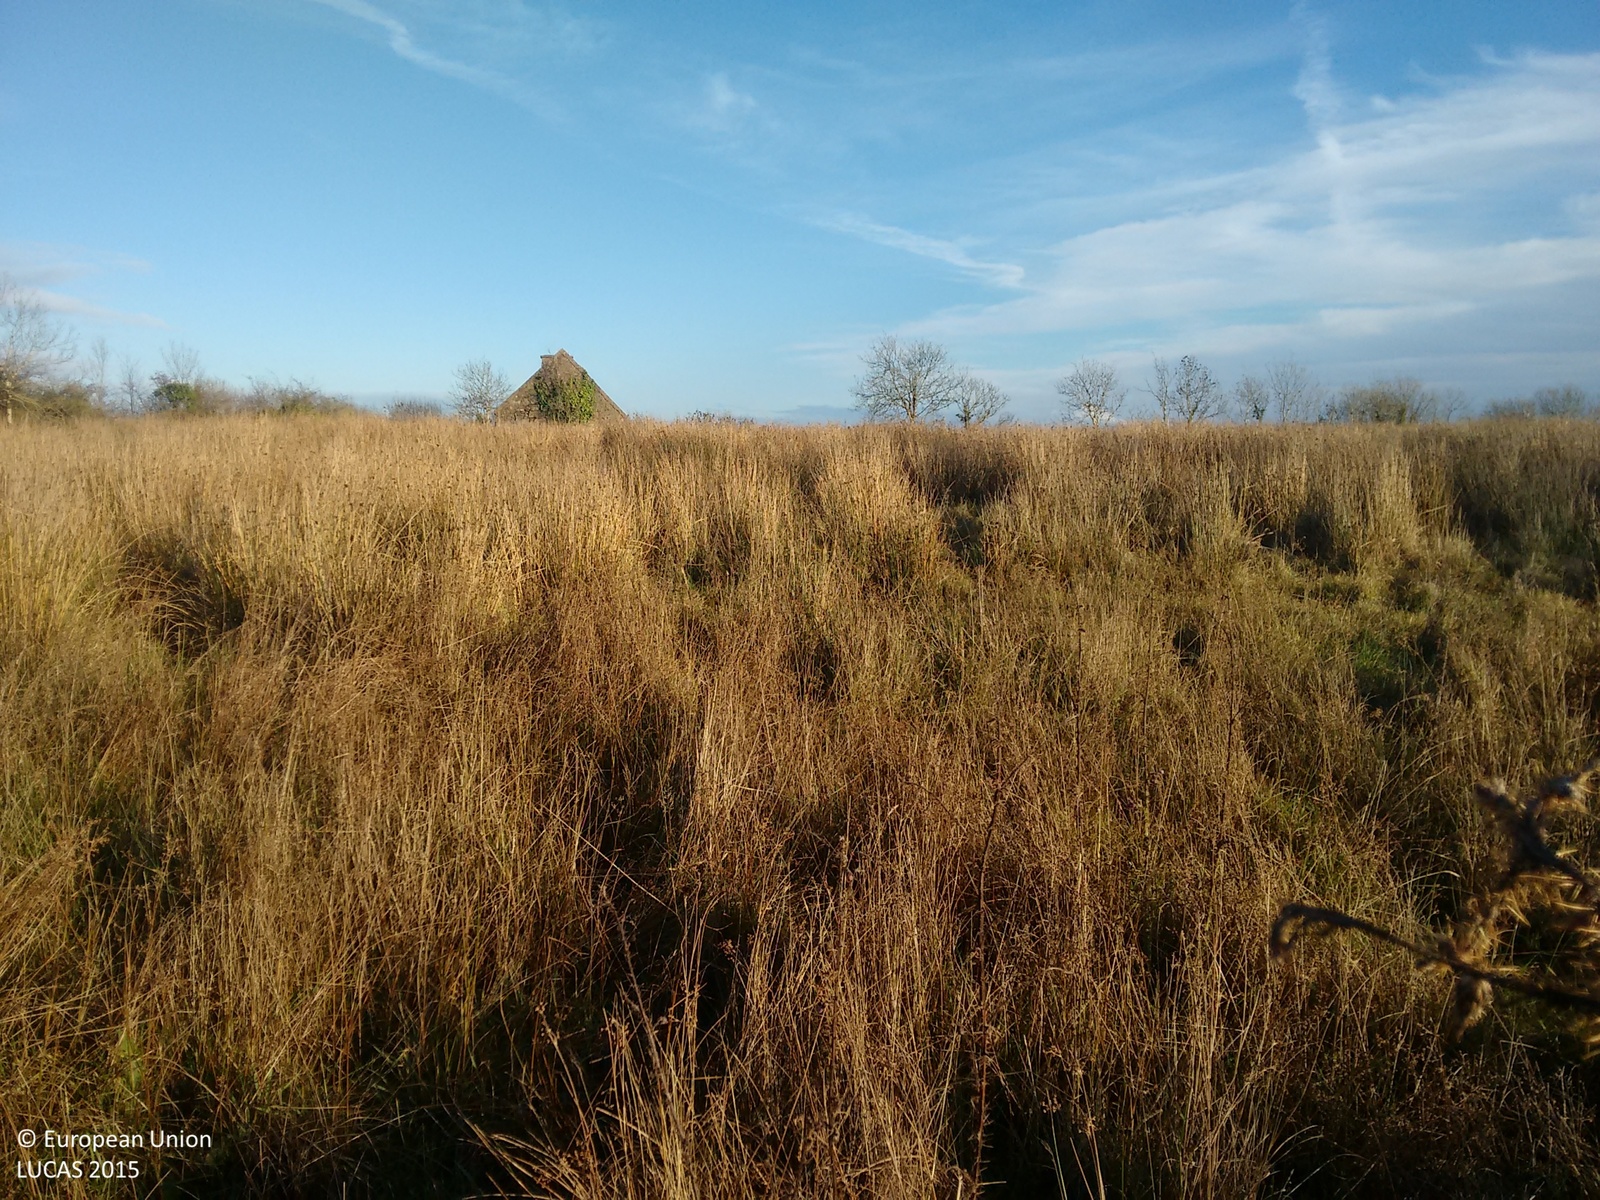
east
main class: Grassland
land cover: Grassland without tree/shrub cover
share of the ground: > 75 %
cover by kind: herbaceous plants 100 %
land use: Agriculture (excluding fallow land and kitchen gardens)
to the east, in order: Grassland without tree/shrub cover; Abandoned hedges; Ditches and canals; Grassland without tree/shrub cover; Fences; Abandoned hedges; Ditches and canals; Broadleaved woodland; Ditches and canals; Grass margins; Paved roads, cycling and walking lanes; Grass margins; Fences; Electric lines; Grassland without tree/shrub cover
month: November
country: IE
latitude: 53.9752
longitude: -7.8710
